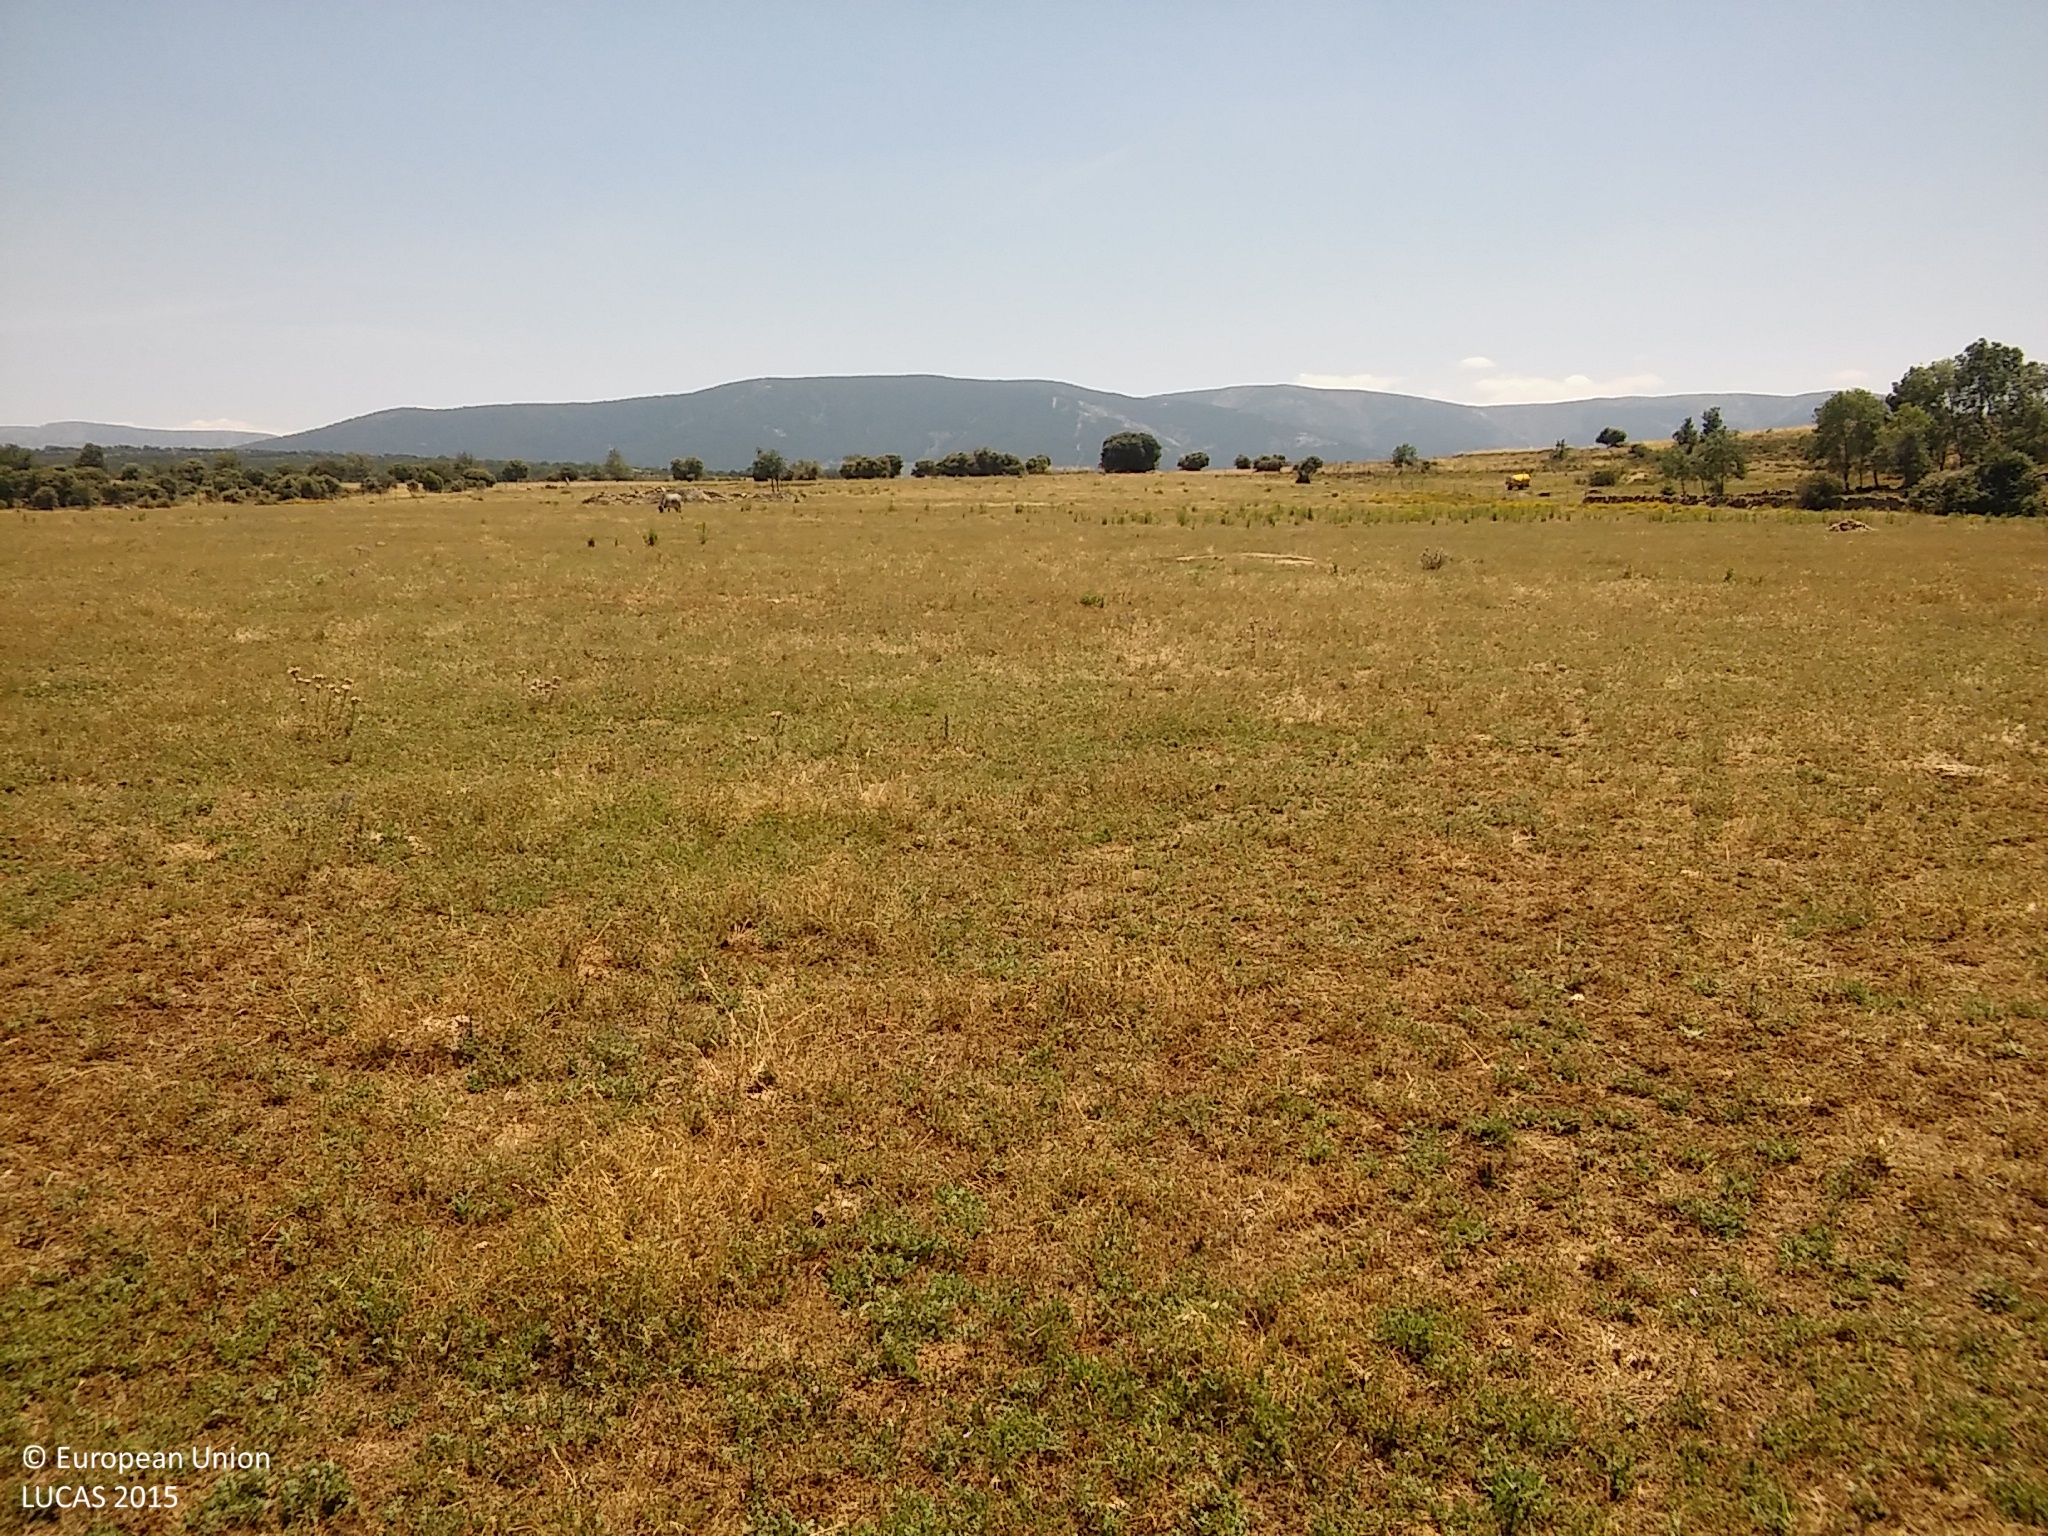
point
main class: Grassland
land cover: Grassland without tree/shrub cover
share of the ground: > 75 %
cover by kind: herbaceous plants 100 %
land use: Agriculture (excluding fallow land and kitchen gardens)
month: June
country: ES
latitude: 41.0806
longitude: -3.9401
